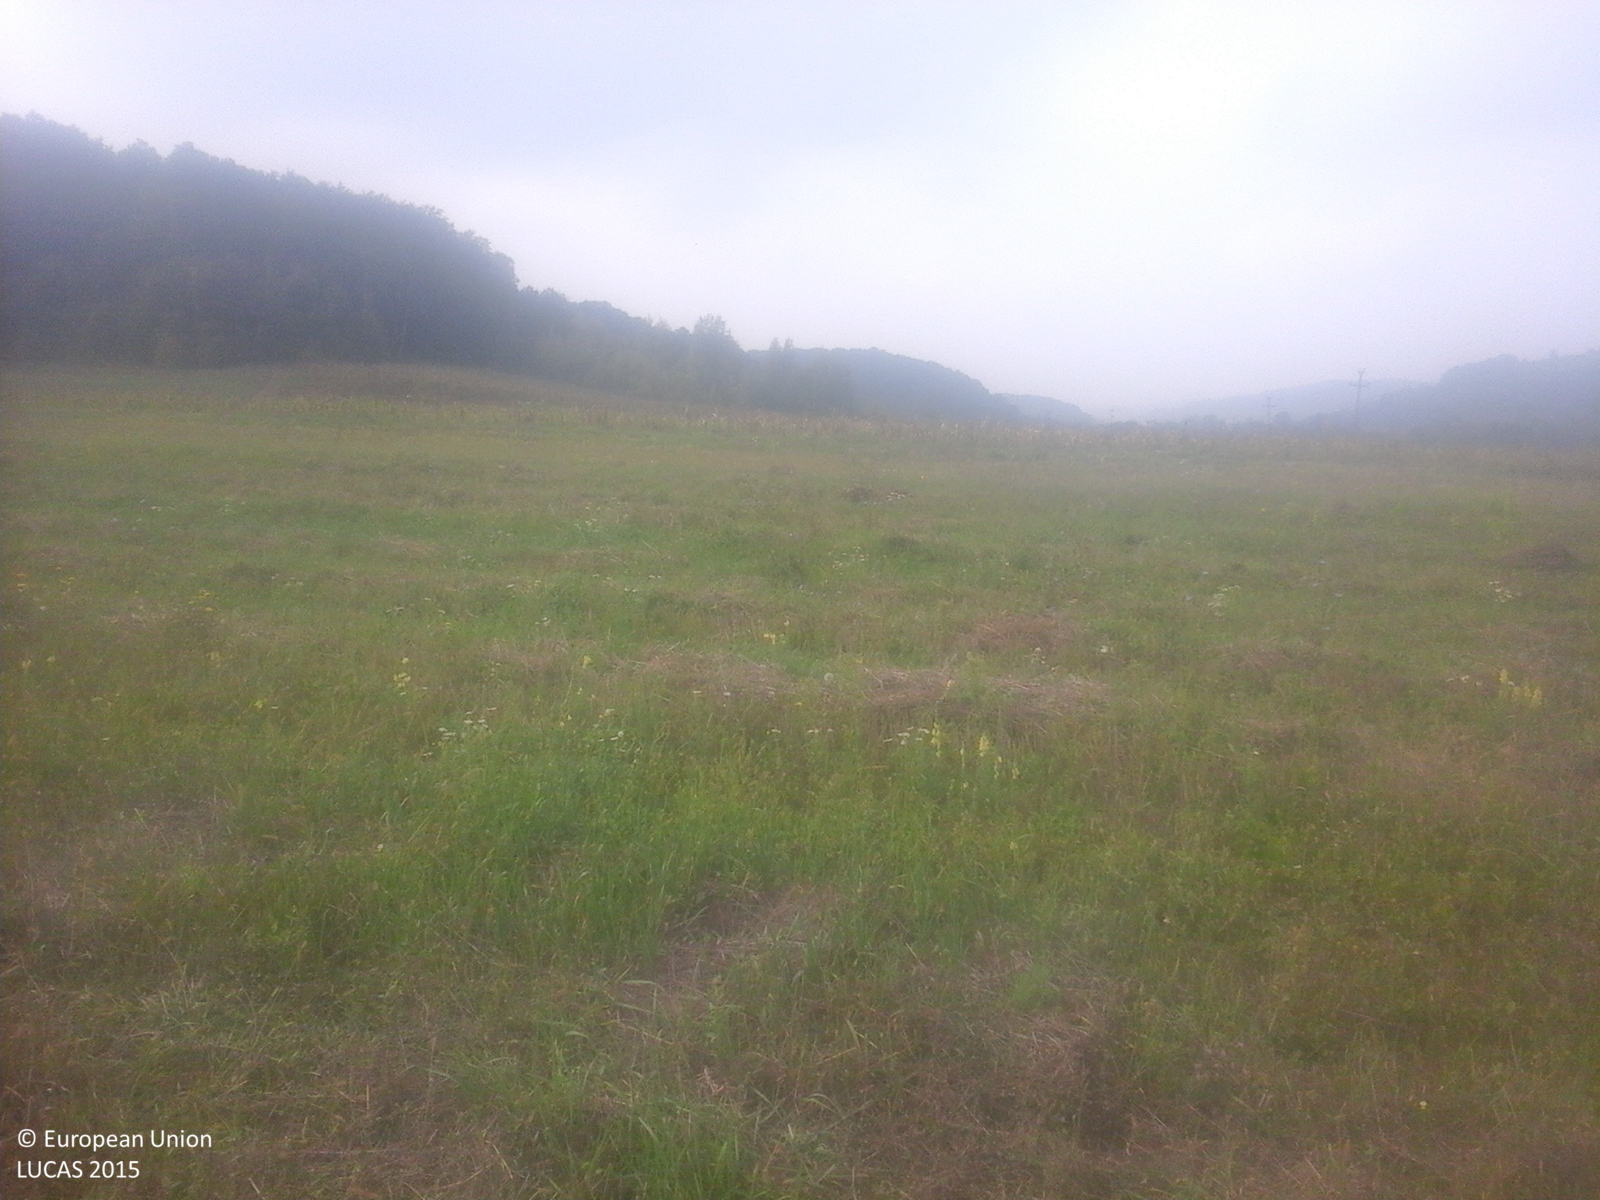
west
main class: Cropland
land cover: Temporary grasslands
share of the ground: > 75 %
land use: Agriculture (excluding fallow land and kitchen gardens)
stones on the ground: < 10 %
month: September
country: RO
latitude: 44.7718
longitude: 23.1276
